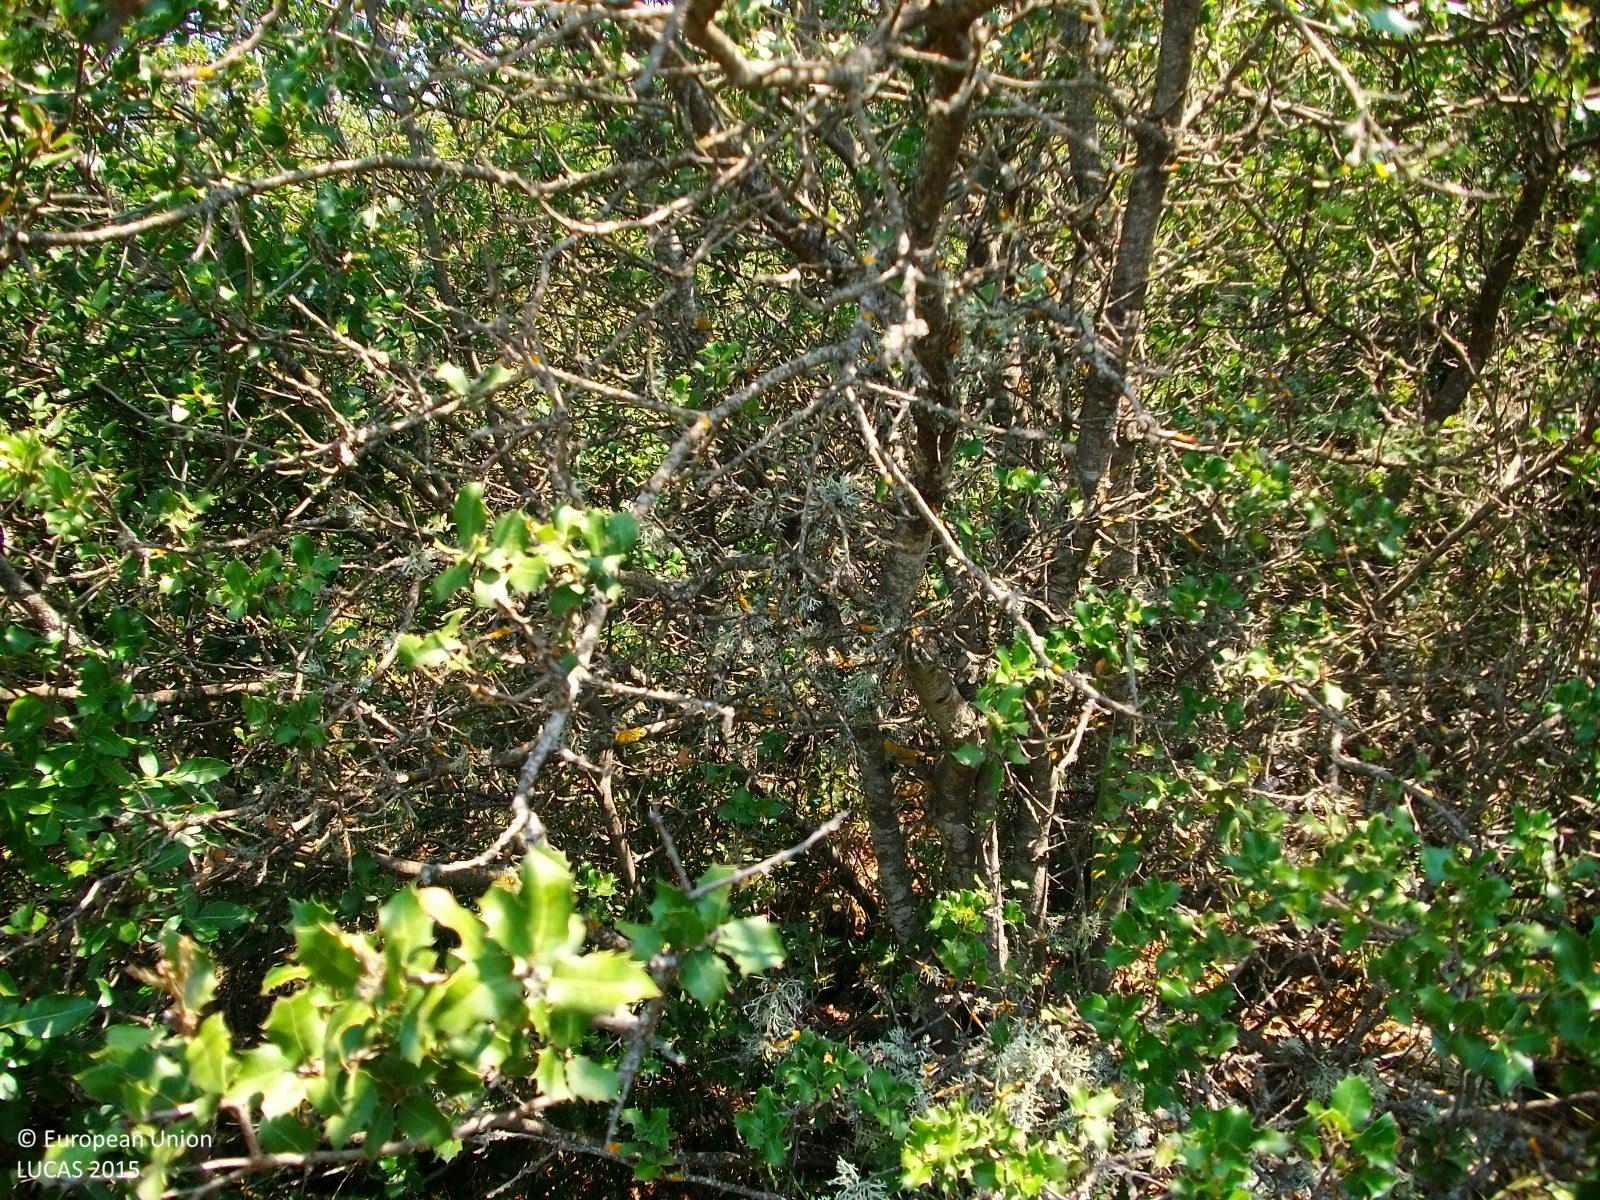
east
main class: Shrubland
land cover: Shrubland with sparse tree cover
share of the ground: > 75 %
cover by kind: shrubs 85 %, broadleaved forest trees 5 %, herbaceous plants 5 %, unconsolidated bare surface 5 %
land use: Agriculture (excluding fallow land and kitchen gardens)
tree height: < 5 m
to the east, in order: Shrubland with sparse tree cover
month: July
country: GR
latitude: 38.6545
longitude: 22.5381
